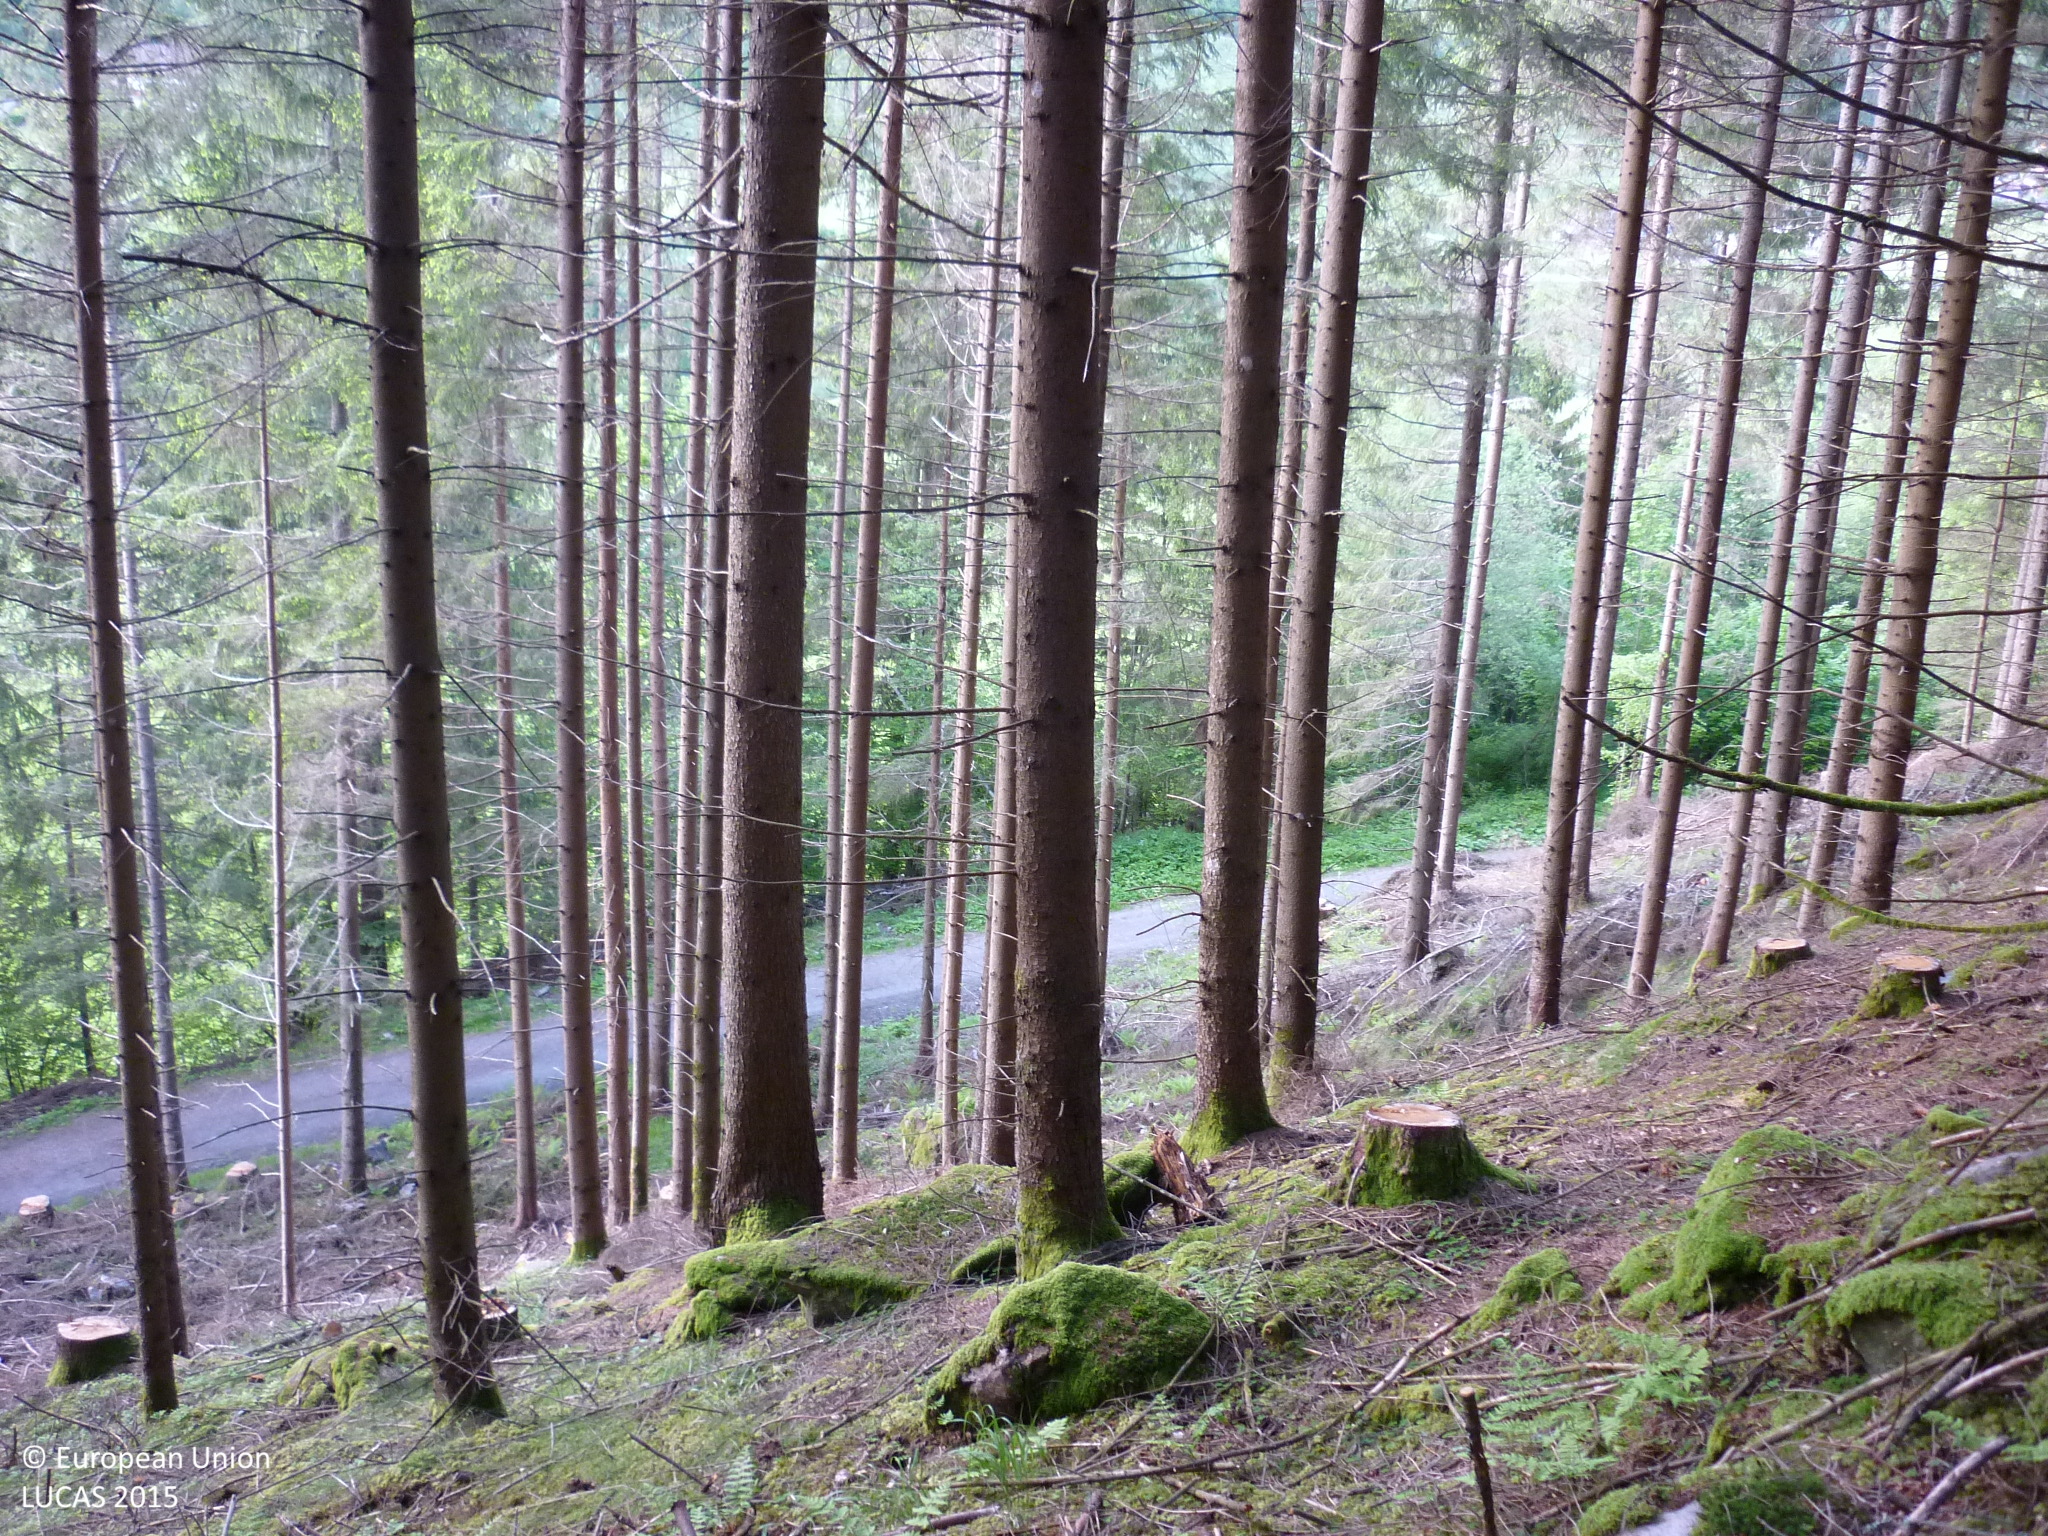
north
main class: Woodland
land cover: Spruce dominated coniferous woodland
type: alpine coniferous forest
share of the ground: > 75 %
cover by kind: coniferous forest trees 90 %, herbaceous plants 5 %, lichens and mosses 5 %
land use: Forestry
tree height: > 5 m
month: May
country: AT
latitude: 47.1052
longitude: 14.0170
